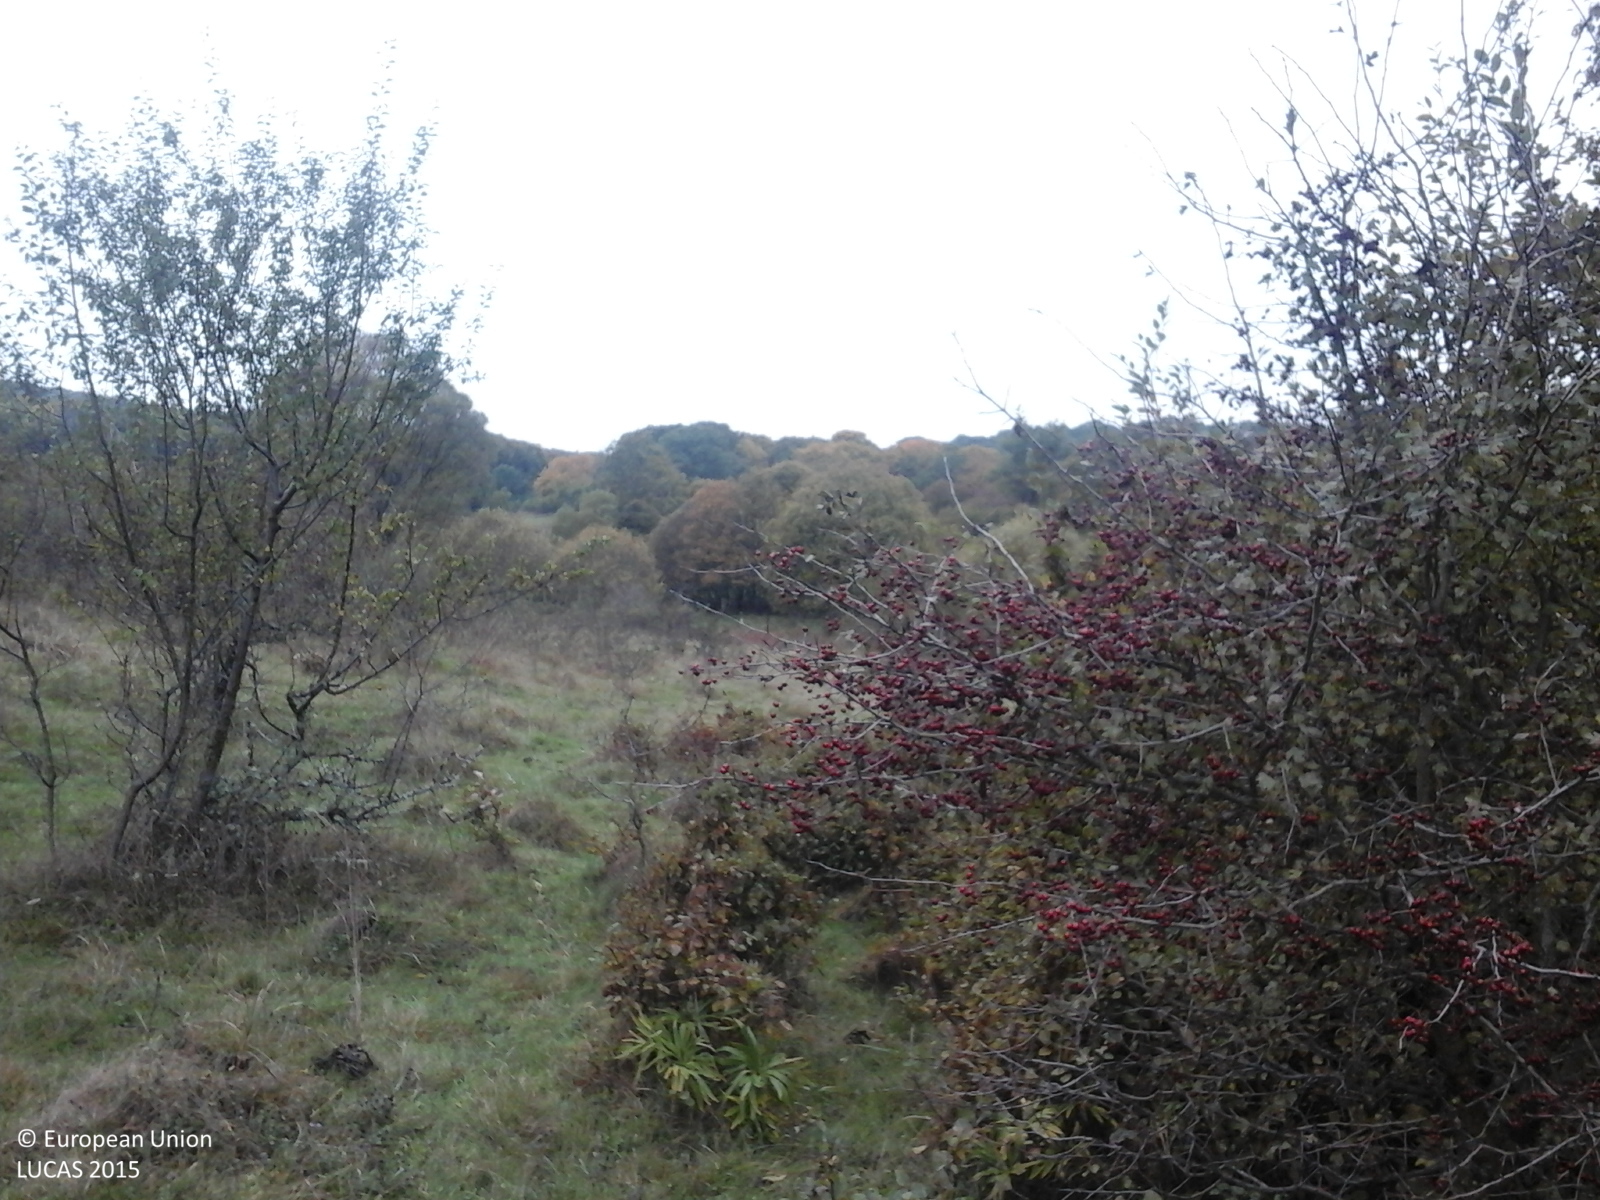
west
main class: Grassland
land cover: Grassland with sparse tree/shrub cover
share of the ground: > 75 %
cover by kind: herbaceous plants 85 %, shrubs 10 %, broadleaved forest trees 5 %
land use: Fallow land
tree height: < 5 m
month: October
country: RO
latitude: 45.9503
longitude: 24.7037
